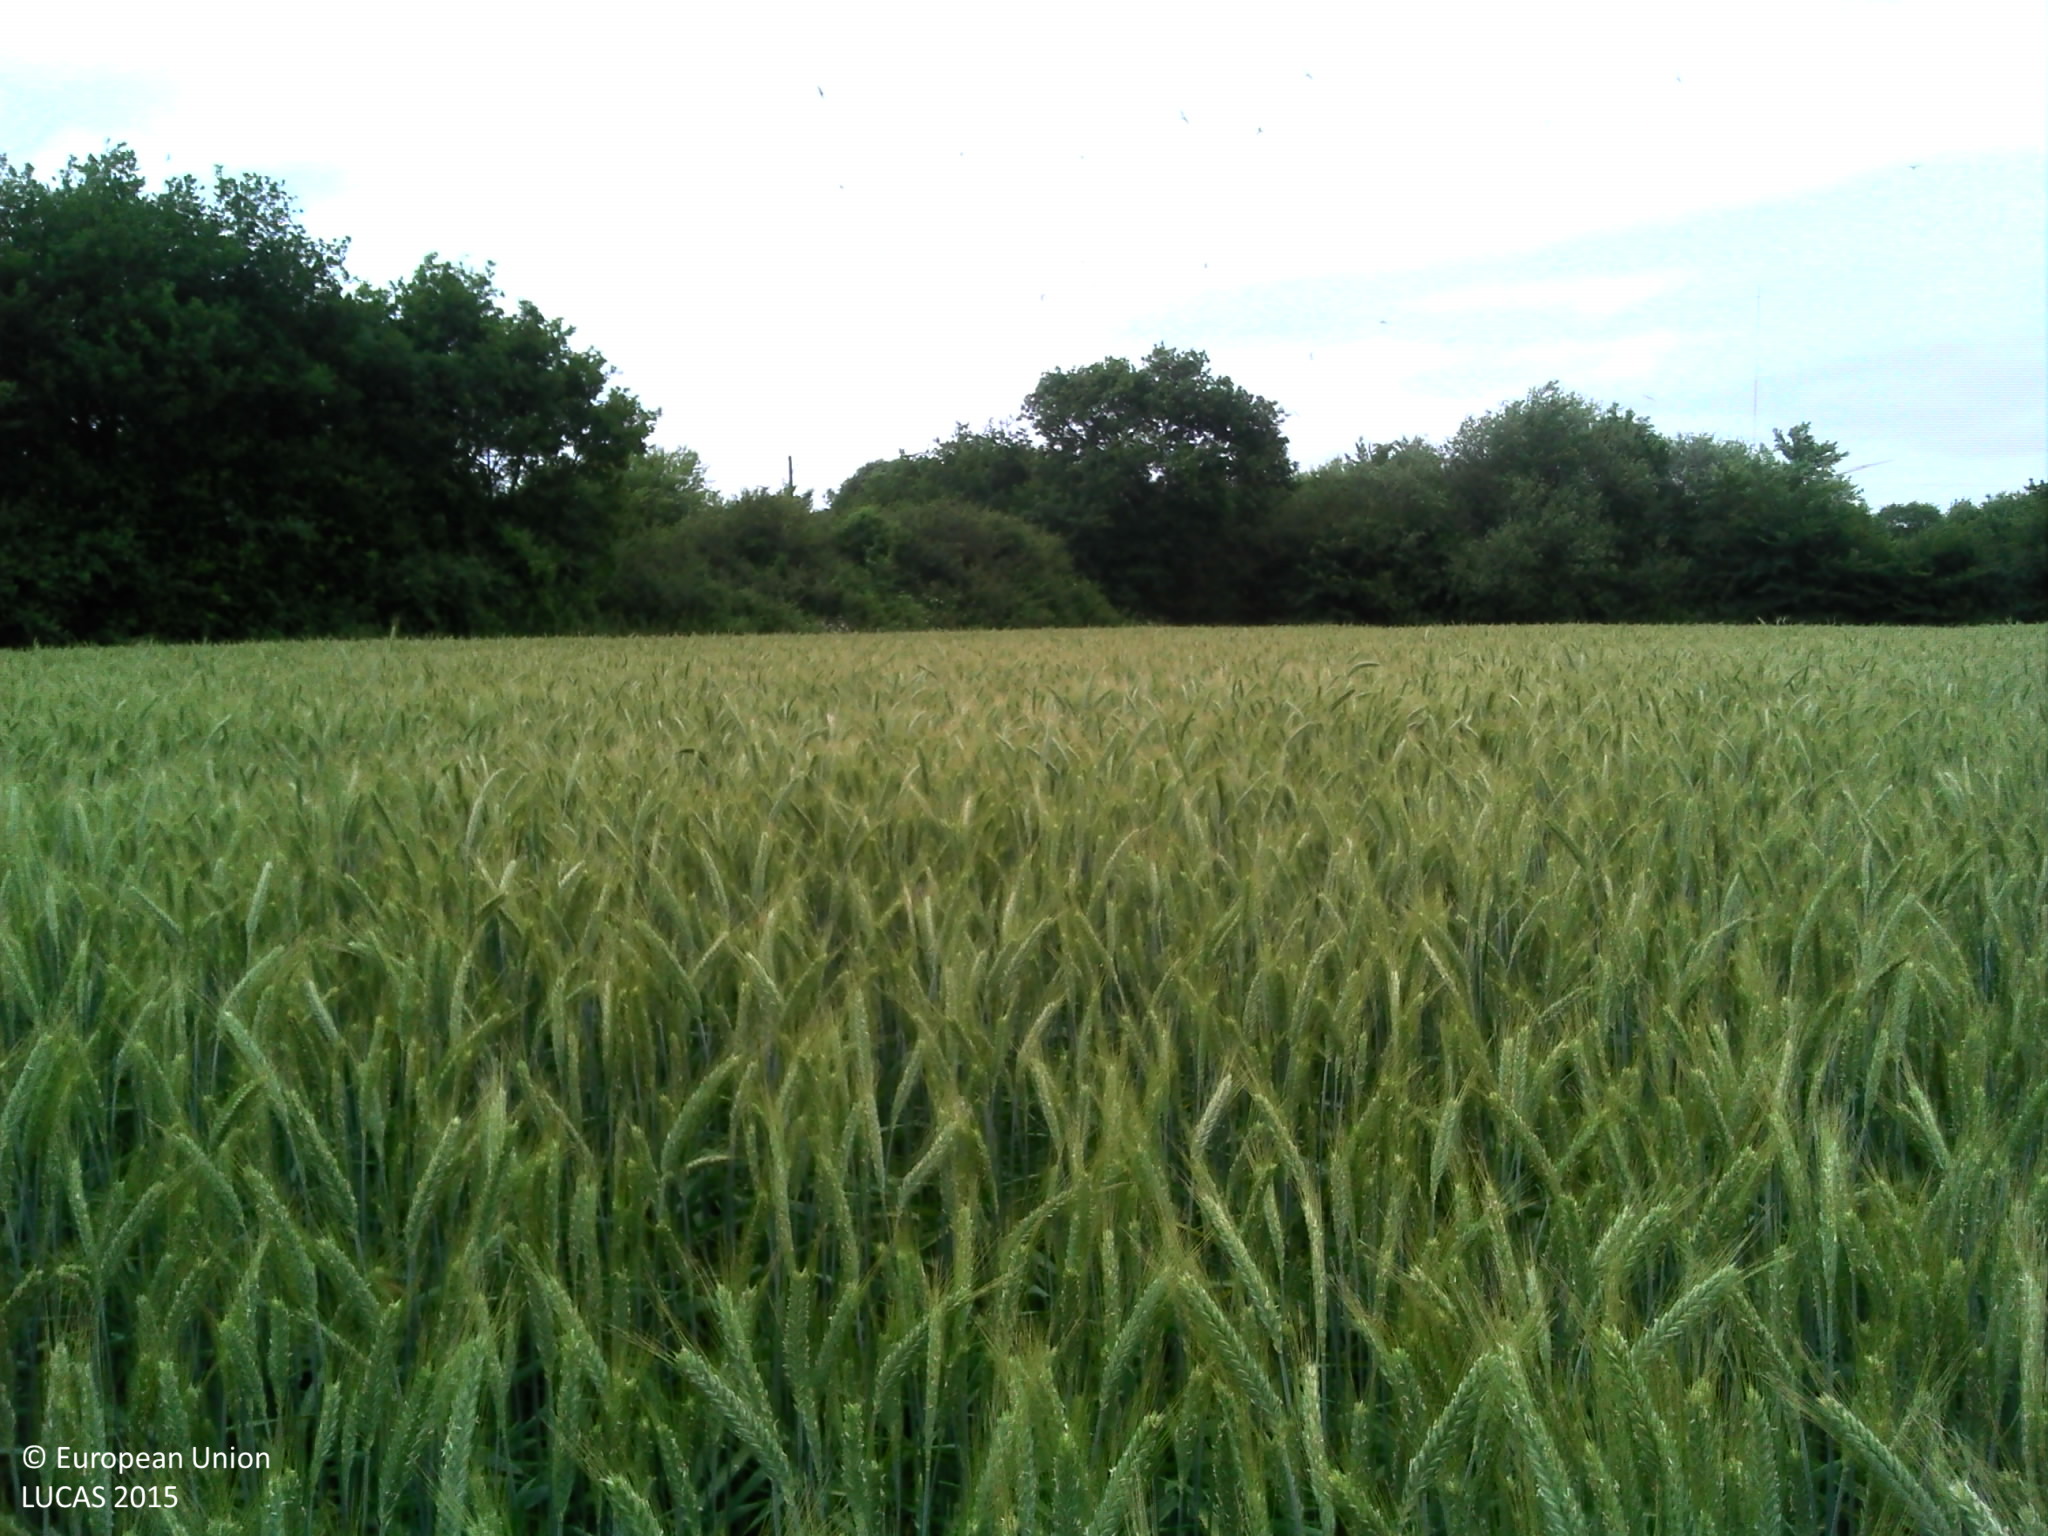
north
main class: Cropland
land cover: Triticale
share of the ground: > 75 %
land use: Agriculture (excluding fallow land and kitchen gardens)
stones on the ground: < 10 %
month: June
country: FR
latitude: 46.8794
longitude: -1.7874
